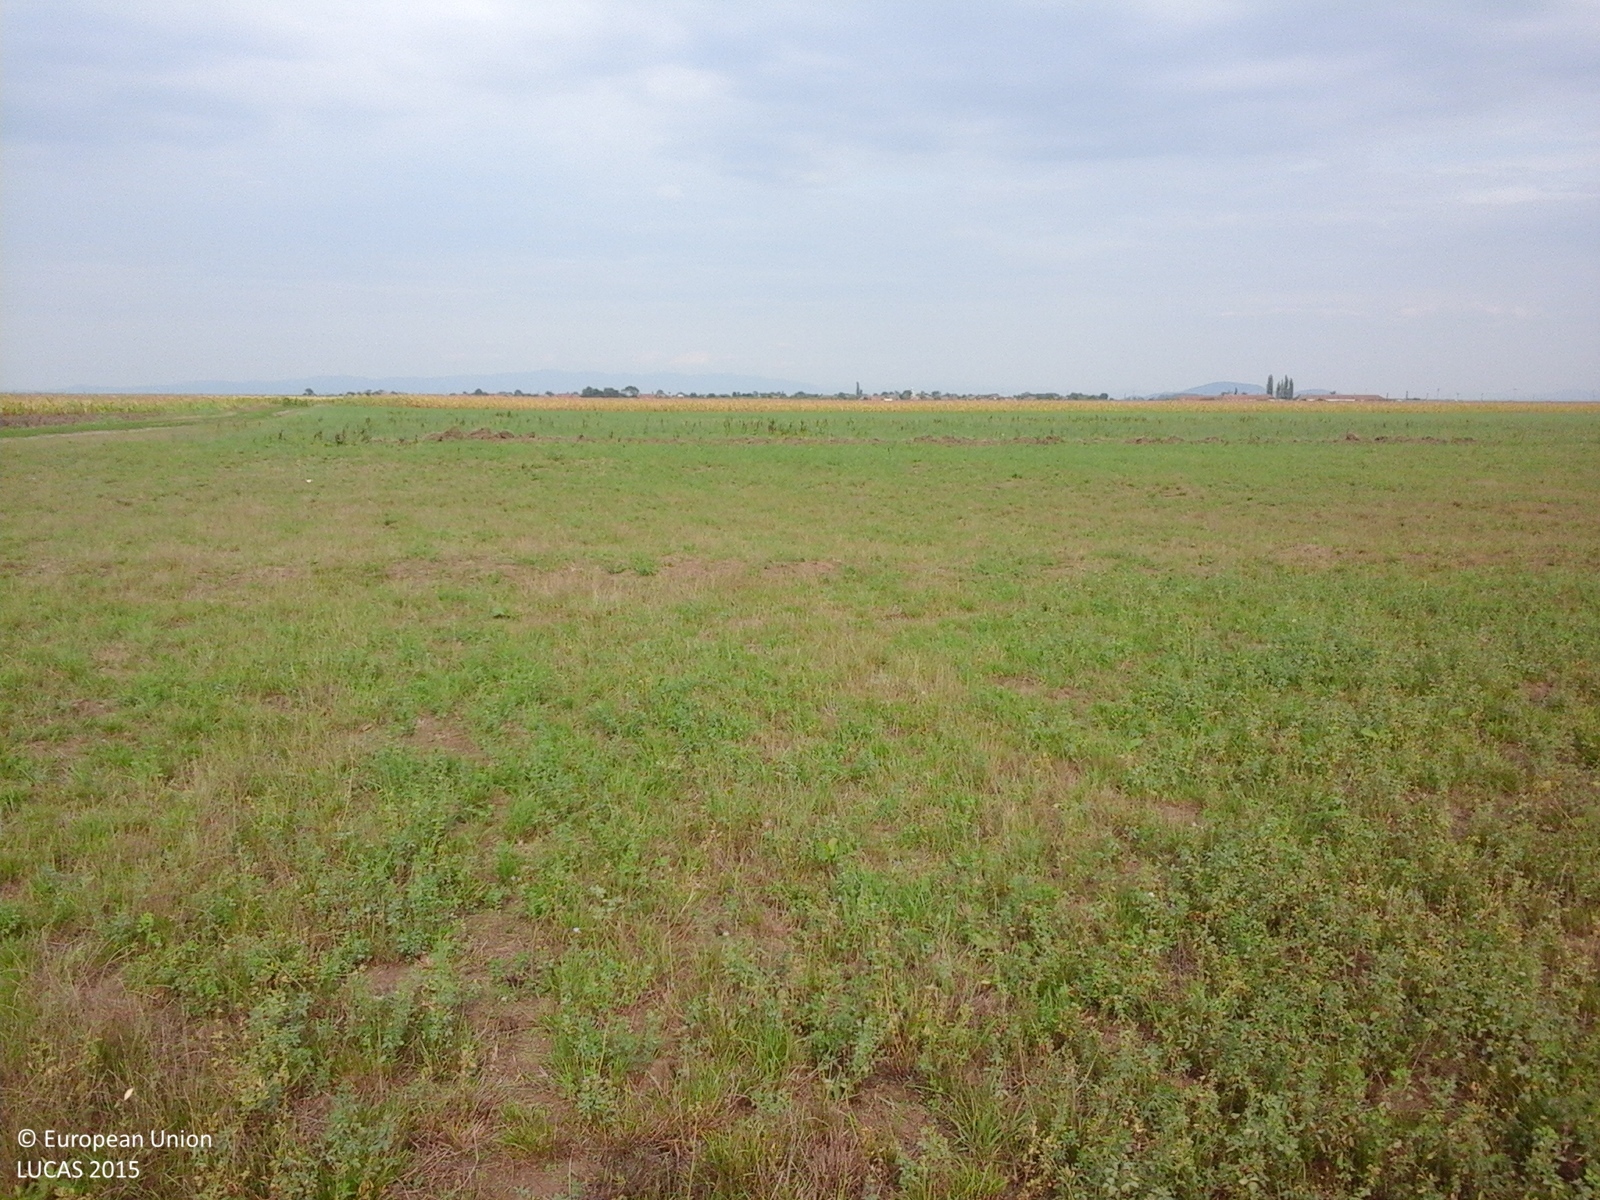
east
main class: Cropland
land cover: Lucerne
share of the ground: > 75 %
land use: Agriculture (excluding fallow land and kitchen gardens)
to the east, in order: Lucerne; Spontaneously vegetated surfaces; Maize; Spontaneously vegetated surfaces; Lucerne
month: August
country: RO
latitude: 46.4113
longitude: 21.5774
